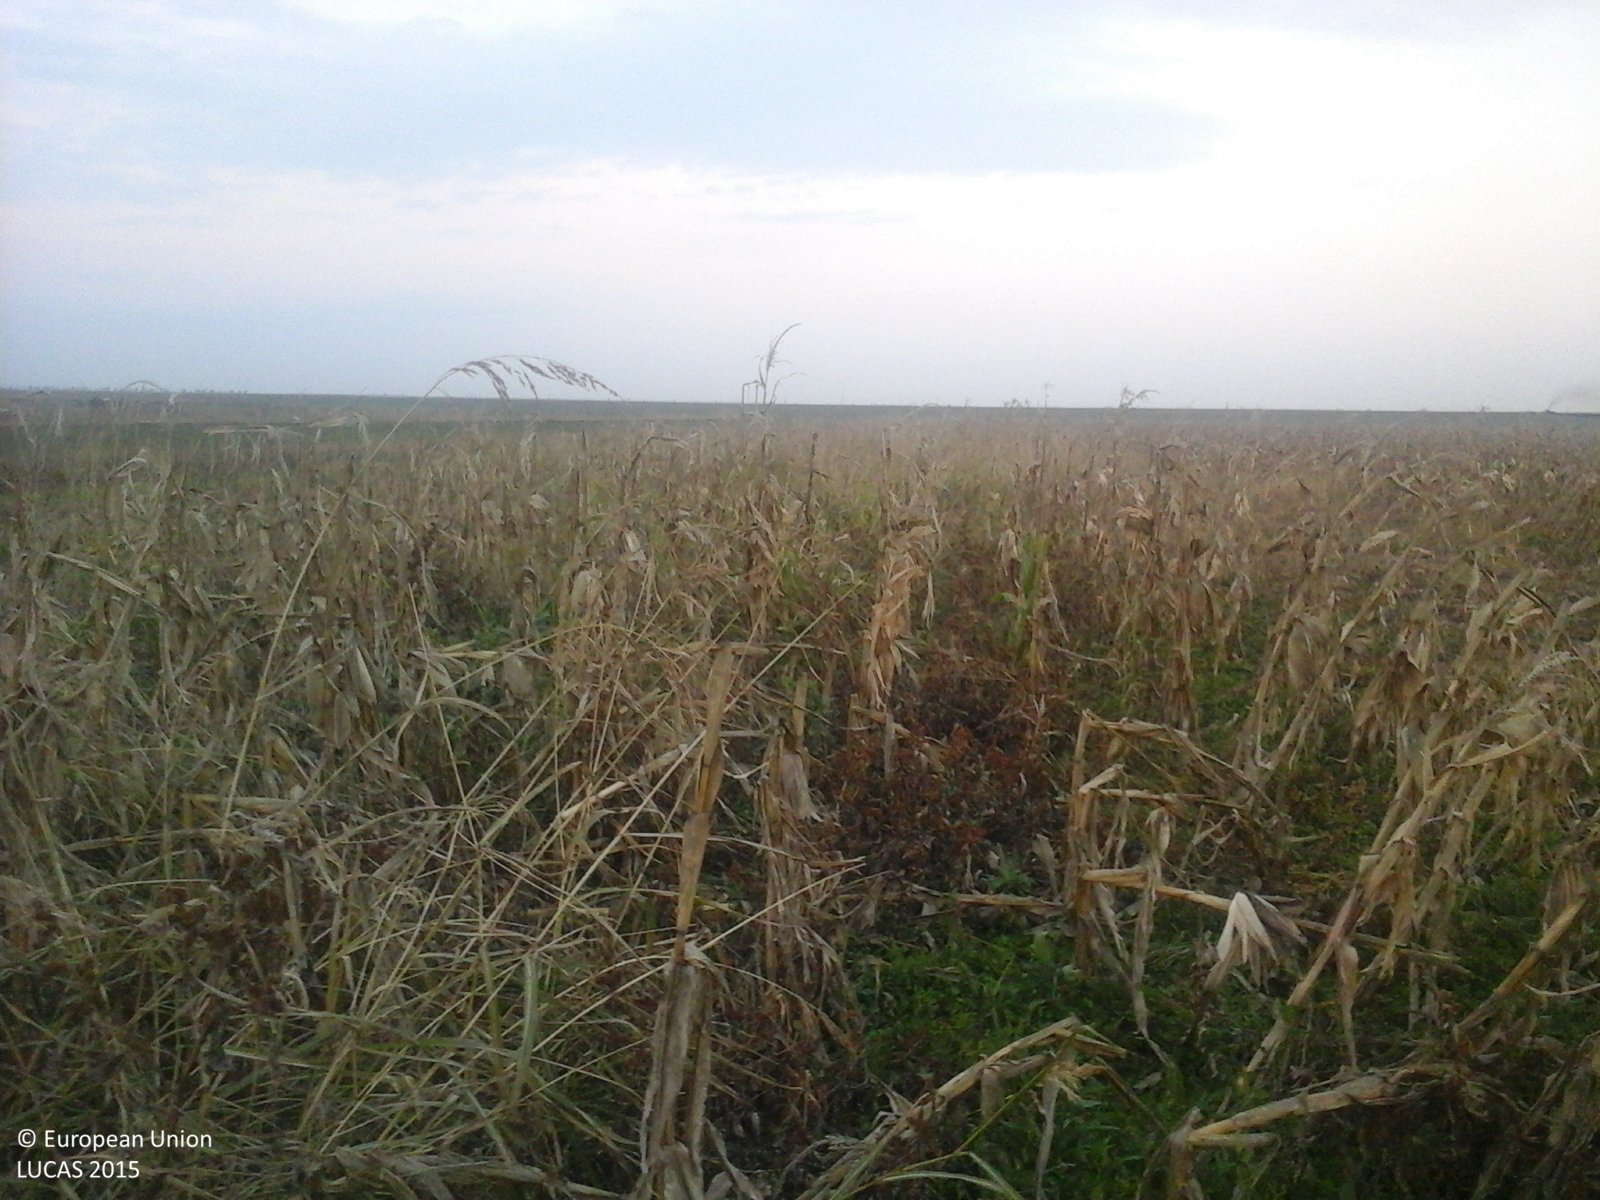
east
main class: Cropland
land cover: Maize
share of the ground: > 75 %
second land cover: Spontaneously vegetated surfaces
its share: 25 - 50 %
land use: Agriculture (excluding fallow land and kitchen gardens)
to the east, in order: Maize; Spontaneously vegetated surfaces; Lucerne; Other bare soil; Maize; Other bare soil; Common wheat
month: October
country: RO
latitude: 45.2677
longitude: 27.0251
